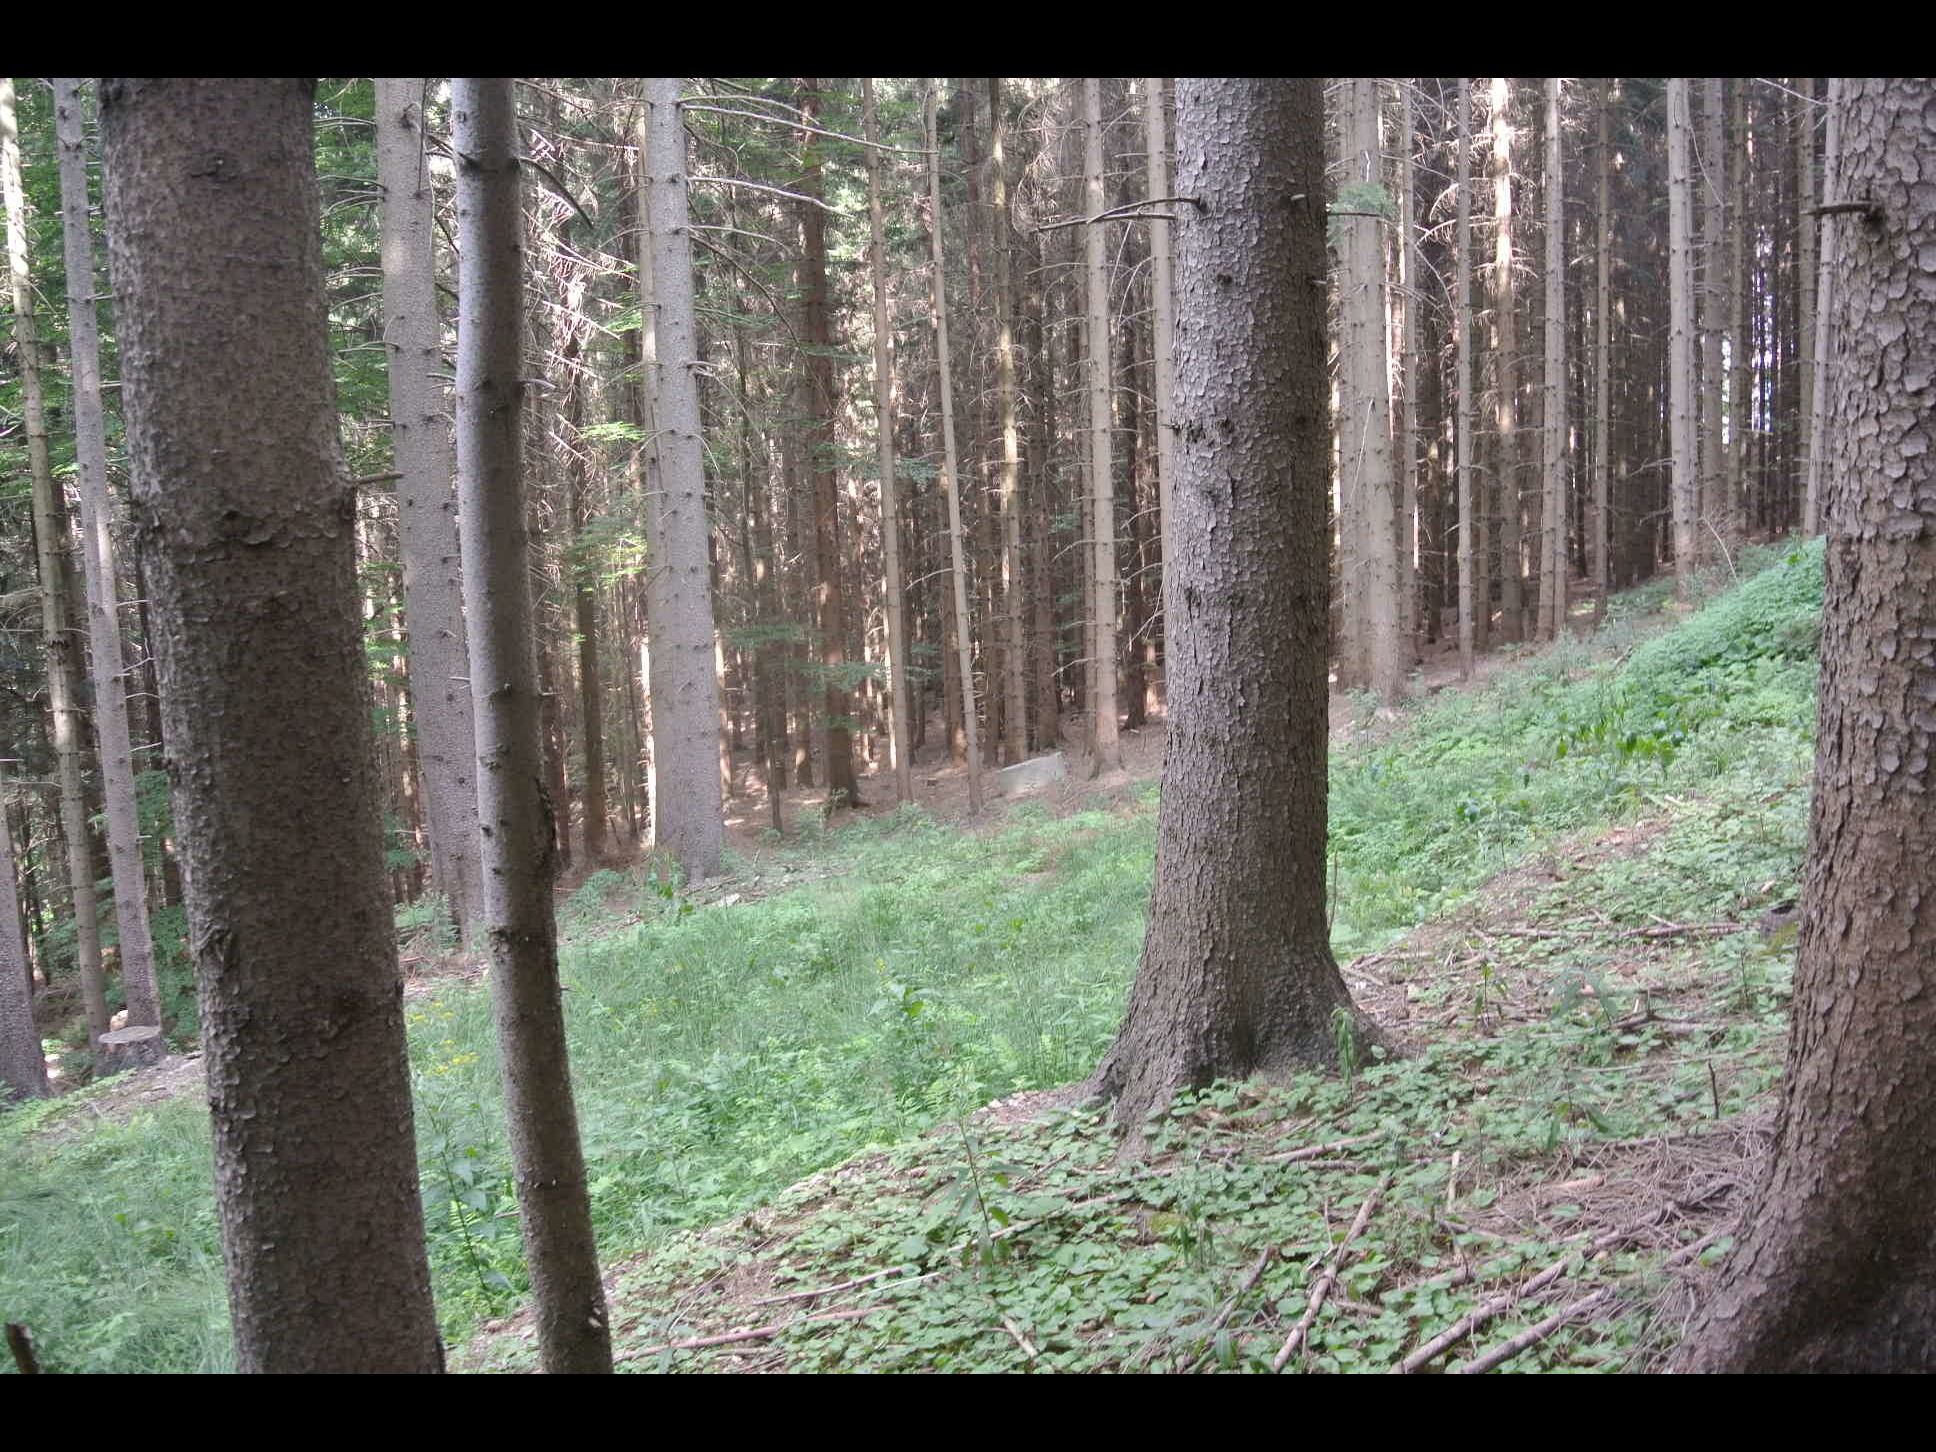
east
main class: Woodland
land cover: Spruce dominated coniferous woodland
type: alpine coniferous forest
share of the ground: > 75 %
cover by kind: coniferous forest trees 70 %, broadleaved forest trees 20 %, herbaceous plants 10 %
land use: Forestry
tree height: > 5 m
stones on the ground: < 10 %
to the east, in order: Spruce dominated coniferous woodland; Tracks; Spruce dominated coniferous woodland; Spruce dominated mixed woodland; Spruce dominated coniferous woodland
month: July
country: AT
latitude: 47.5656
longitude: 16.1302
